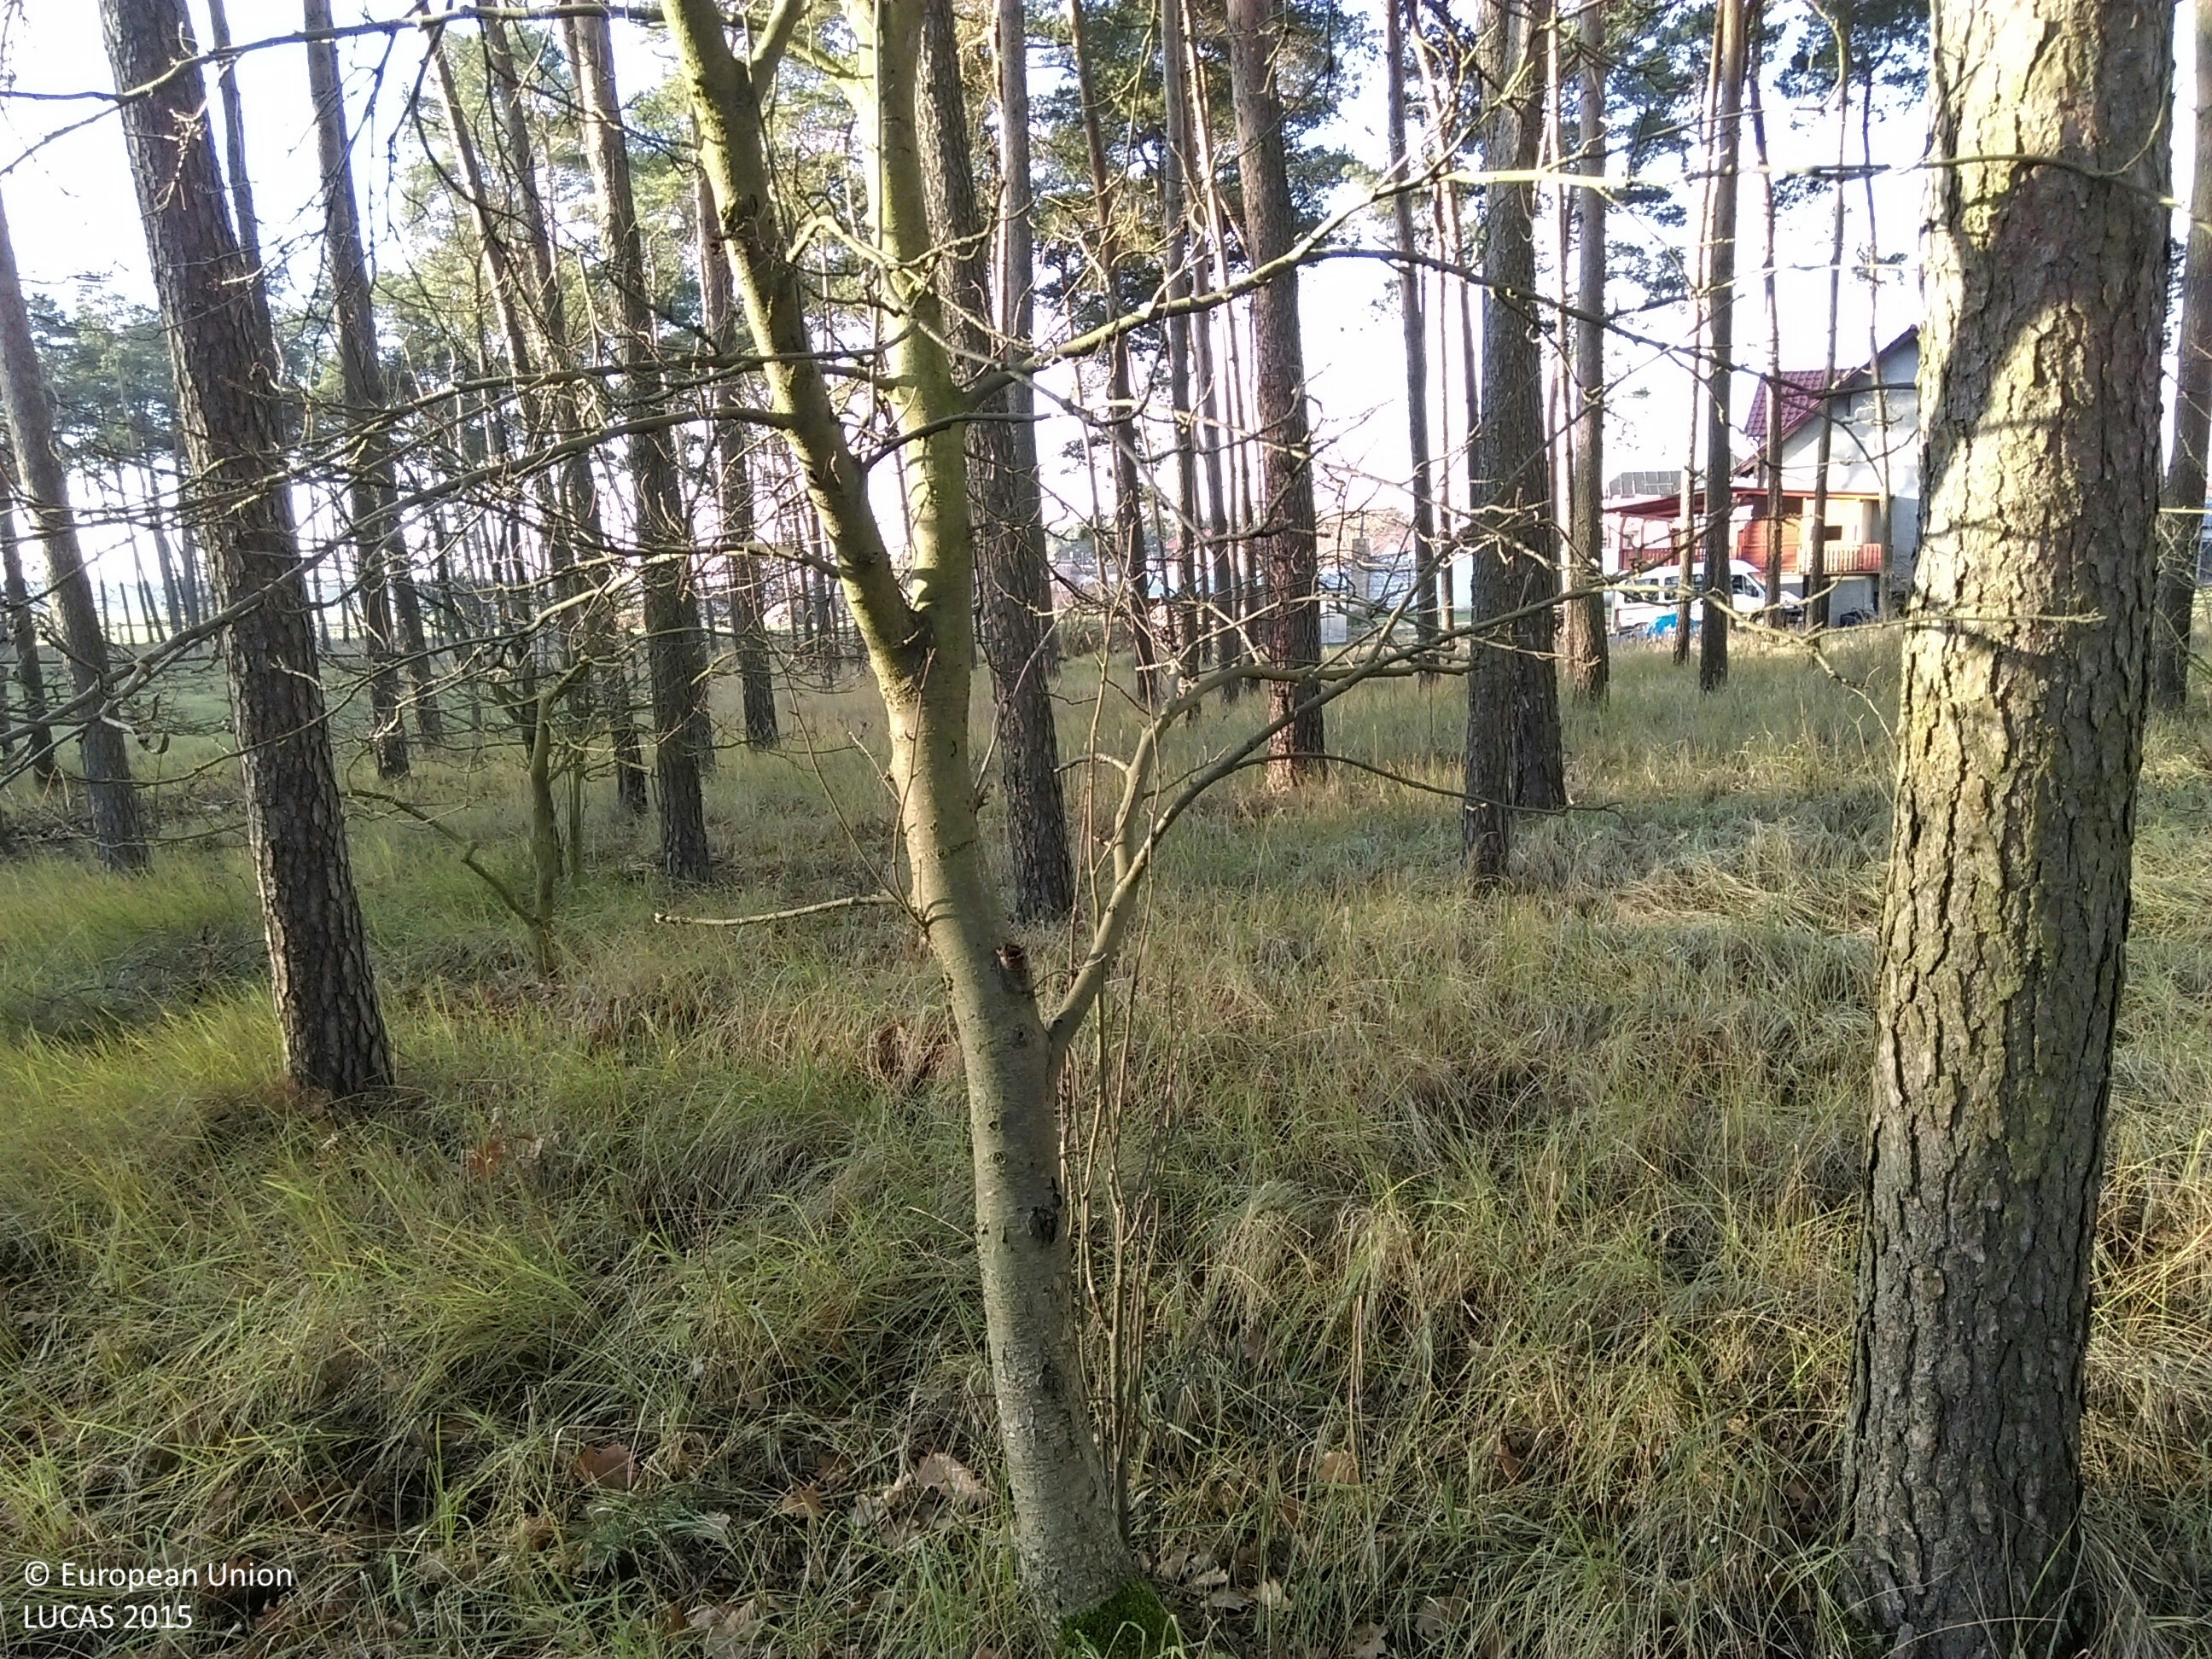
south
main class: Woodland
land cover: Pine dominated coniferous woodland
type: hemiboreal forest and nemoral coniferous forest and mixed broadleaved-coniferous forest
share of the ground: > 75 %
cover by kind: coniferous forest trees 75 %, herbaceous plants 25 %
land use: Forestry
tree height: > 5 m
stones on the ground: < 10 %
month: December
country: PL
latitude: 52.0724
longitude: 16.1777
